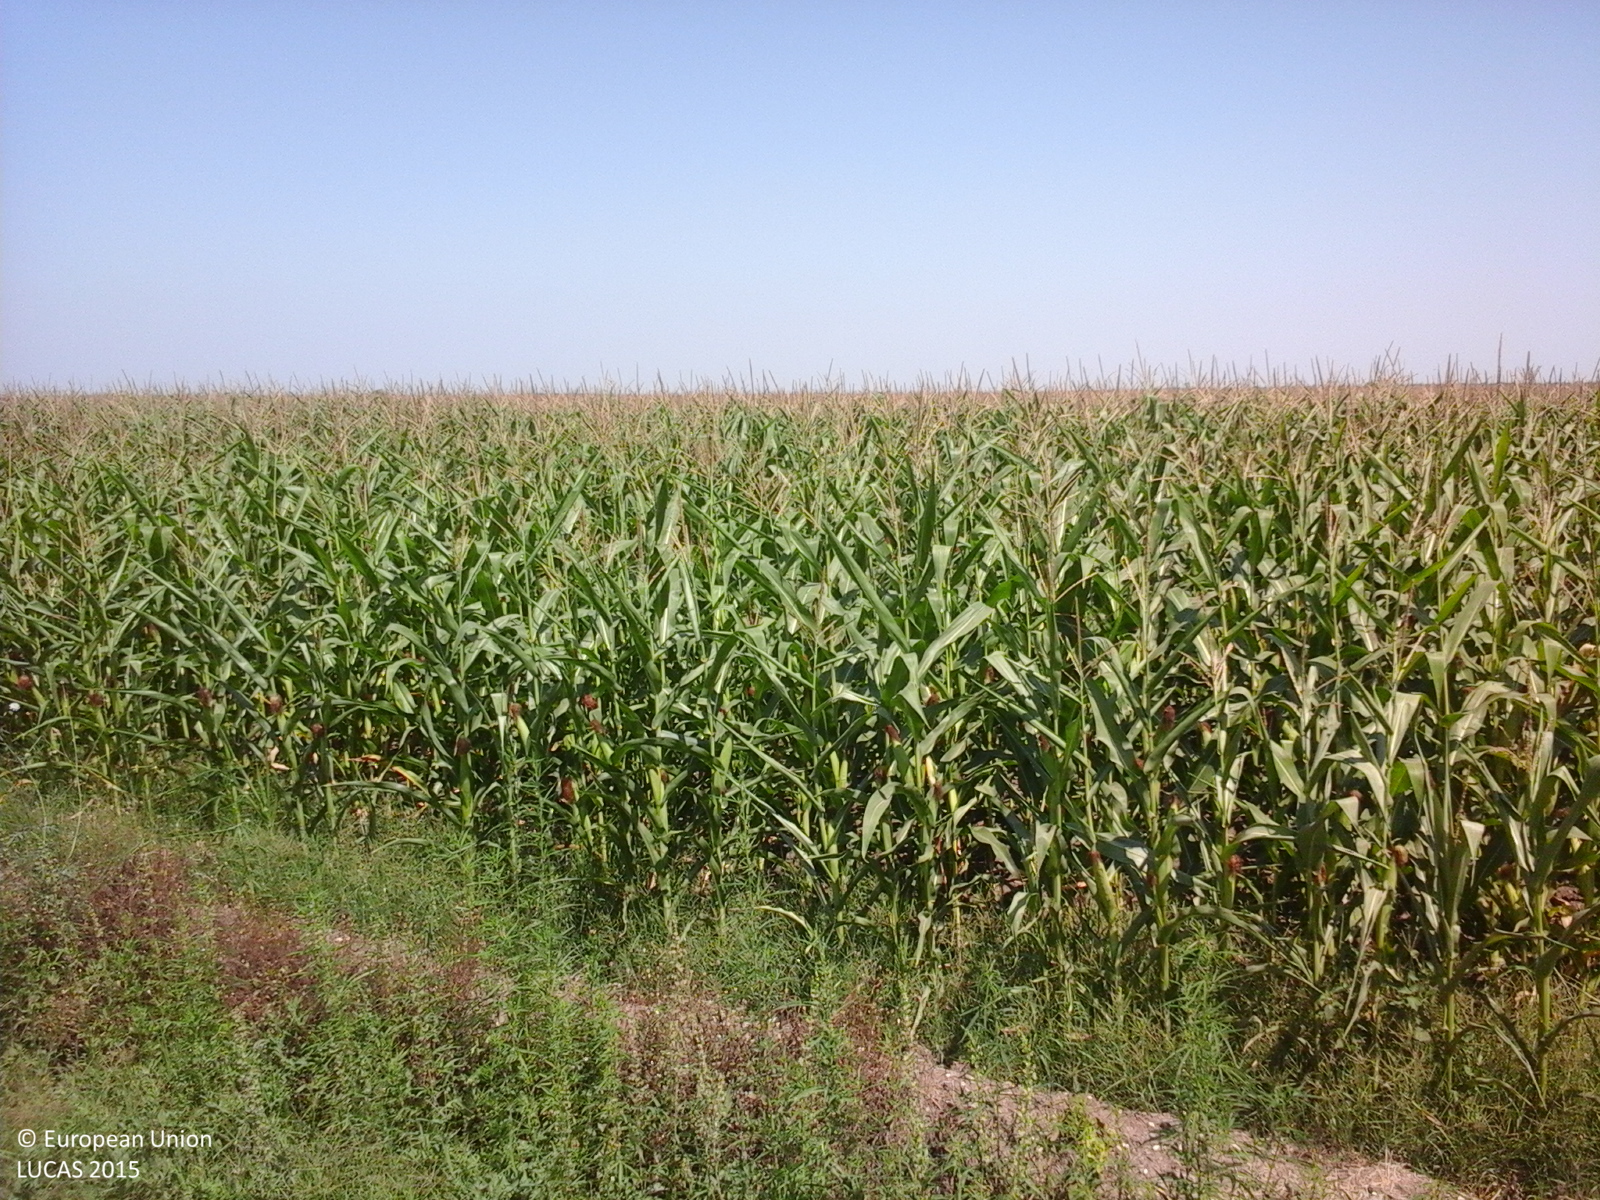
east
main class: Cropland
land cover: Maize
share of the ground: > 75 %
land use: Agriculture (excluding fallow land and kitchen gardens)
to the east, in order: Maize; Shruby margins; Tracks; Shruby margins; Maize
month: July
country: RO
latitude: 44.4436
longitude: 27.0029
